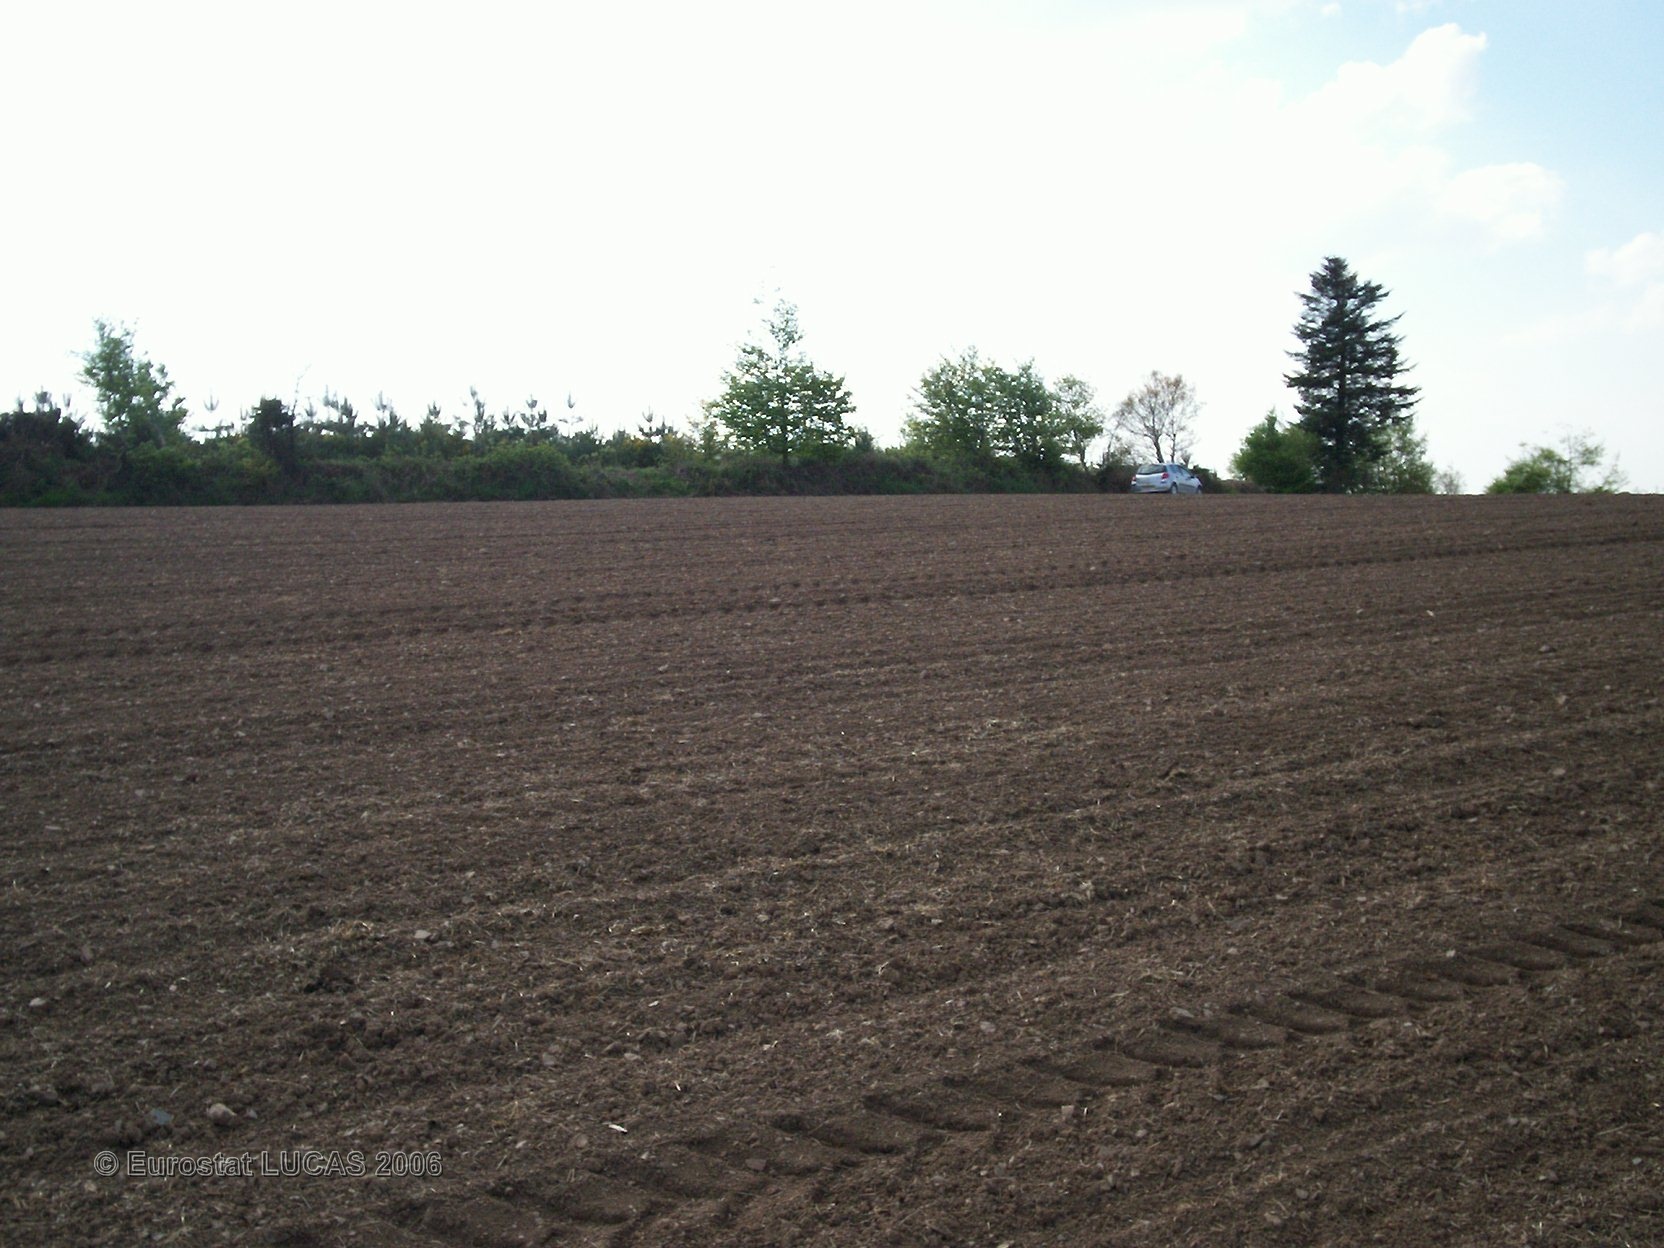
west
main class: Bare land
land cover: Bare land
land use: Agriculture (excluding fallow land and kitchen gardens)
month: May
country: FR
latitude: 48.3766
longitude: -3.6222
